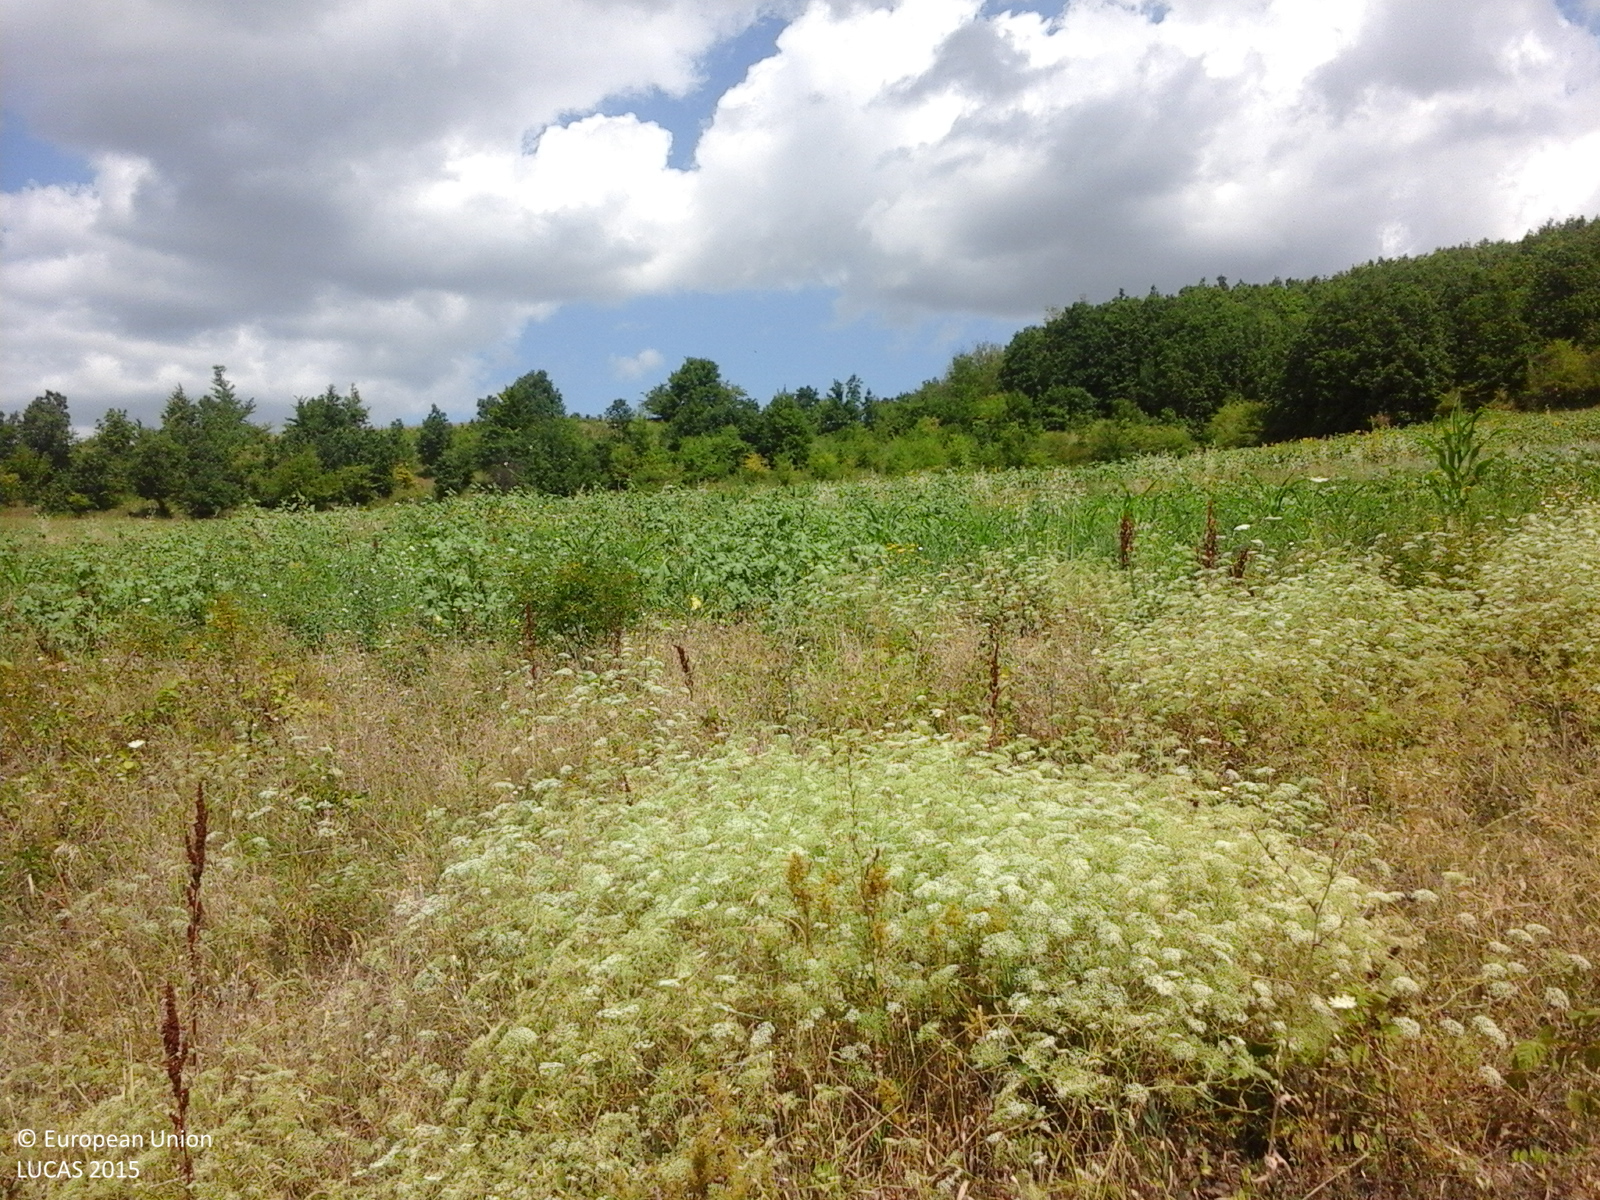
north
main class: Grassland
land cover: Spontaneously vegetated surfaces
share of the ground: > 75 %
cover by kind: herbaceous plants 100 %
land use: Fallow land
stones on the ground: < 10 %
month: July
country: RO
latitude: 46.4596
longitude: 27.3853
